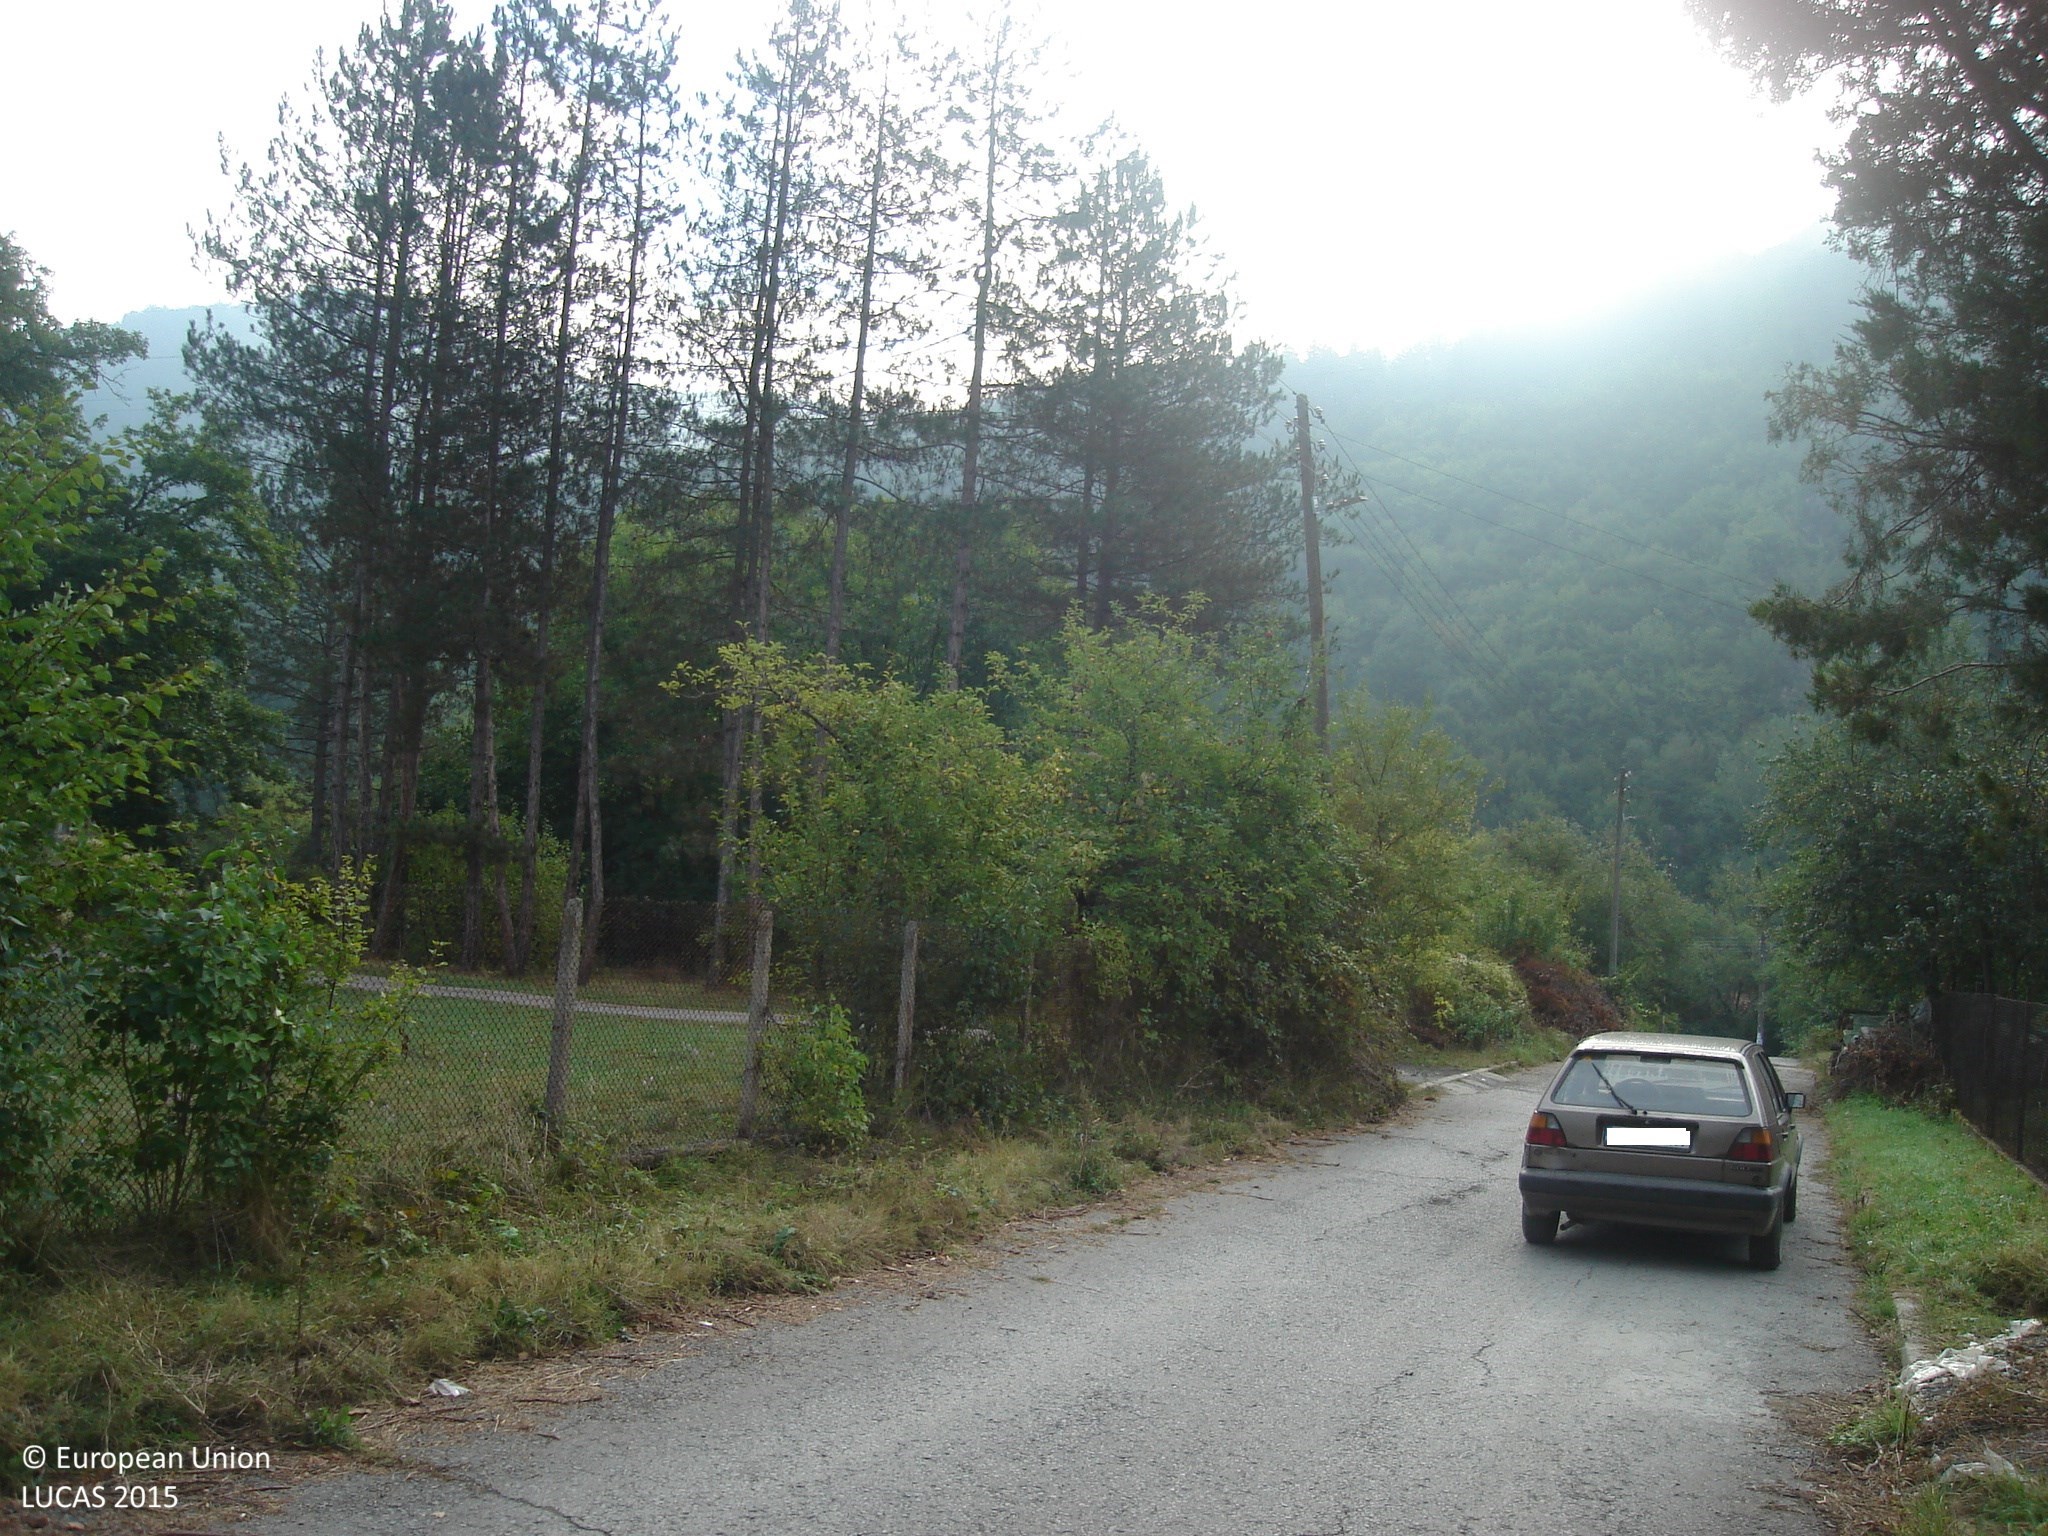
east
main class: Woodland
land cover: Broadleaved woodland
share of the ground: > 75 %
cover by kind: broadleaved forest trees 80 %
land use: Residential
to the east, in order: Broadleaved woodland; Artificial constructions in urban areas; Broadleaved woodland; Tracks; Grassland with sparse tree/shrub cover; Inland fresh running water; Broadleaved woodland
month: September
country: BG
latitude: 42.9314
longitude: 23.3811
